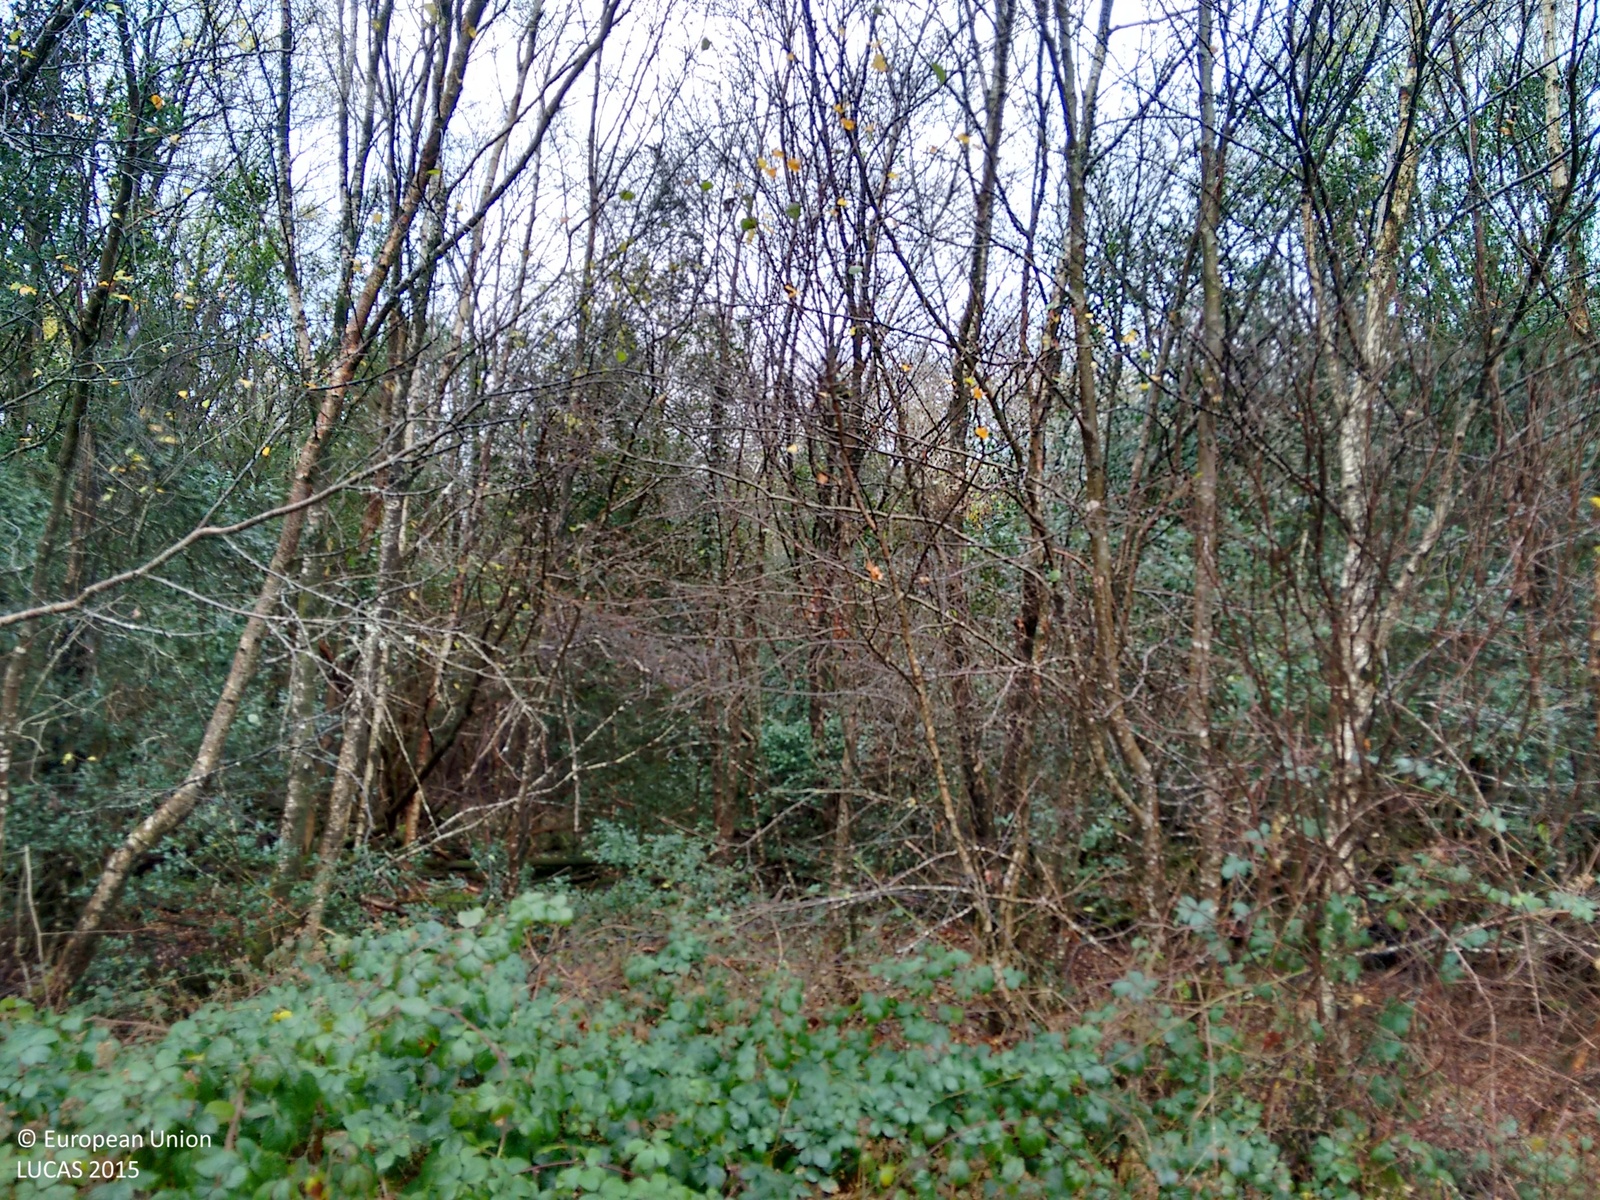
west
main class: Woodland
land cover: Broadleaved woodland
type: mesophytic deciduous forest
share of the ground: > 75 %
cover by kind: broadleaved forest trees 60 %, herbaceous plants 40 %
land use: Agriculture (excluding fallow land and kitchen gardens)
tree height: > 5 m
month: November
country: IE
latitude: 54.3436
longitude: -8.0020
